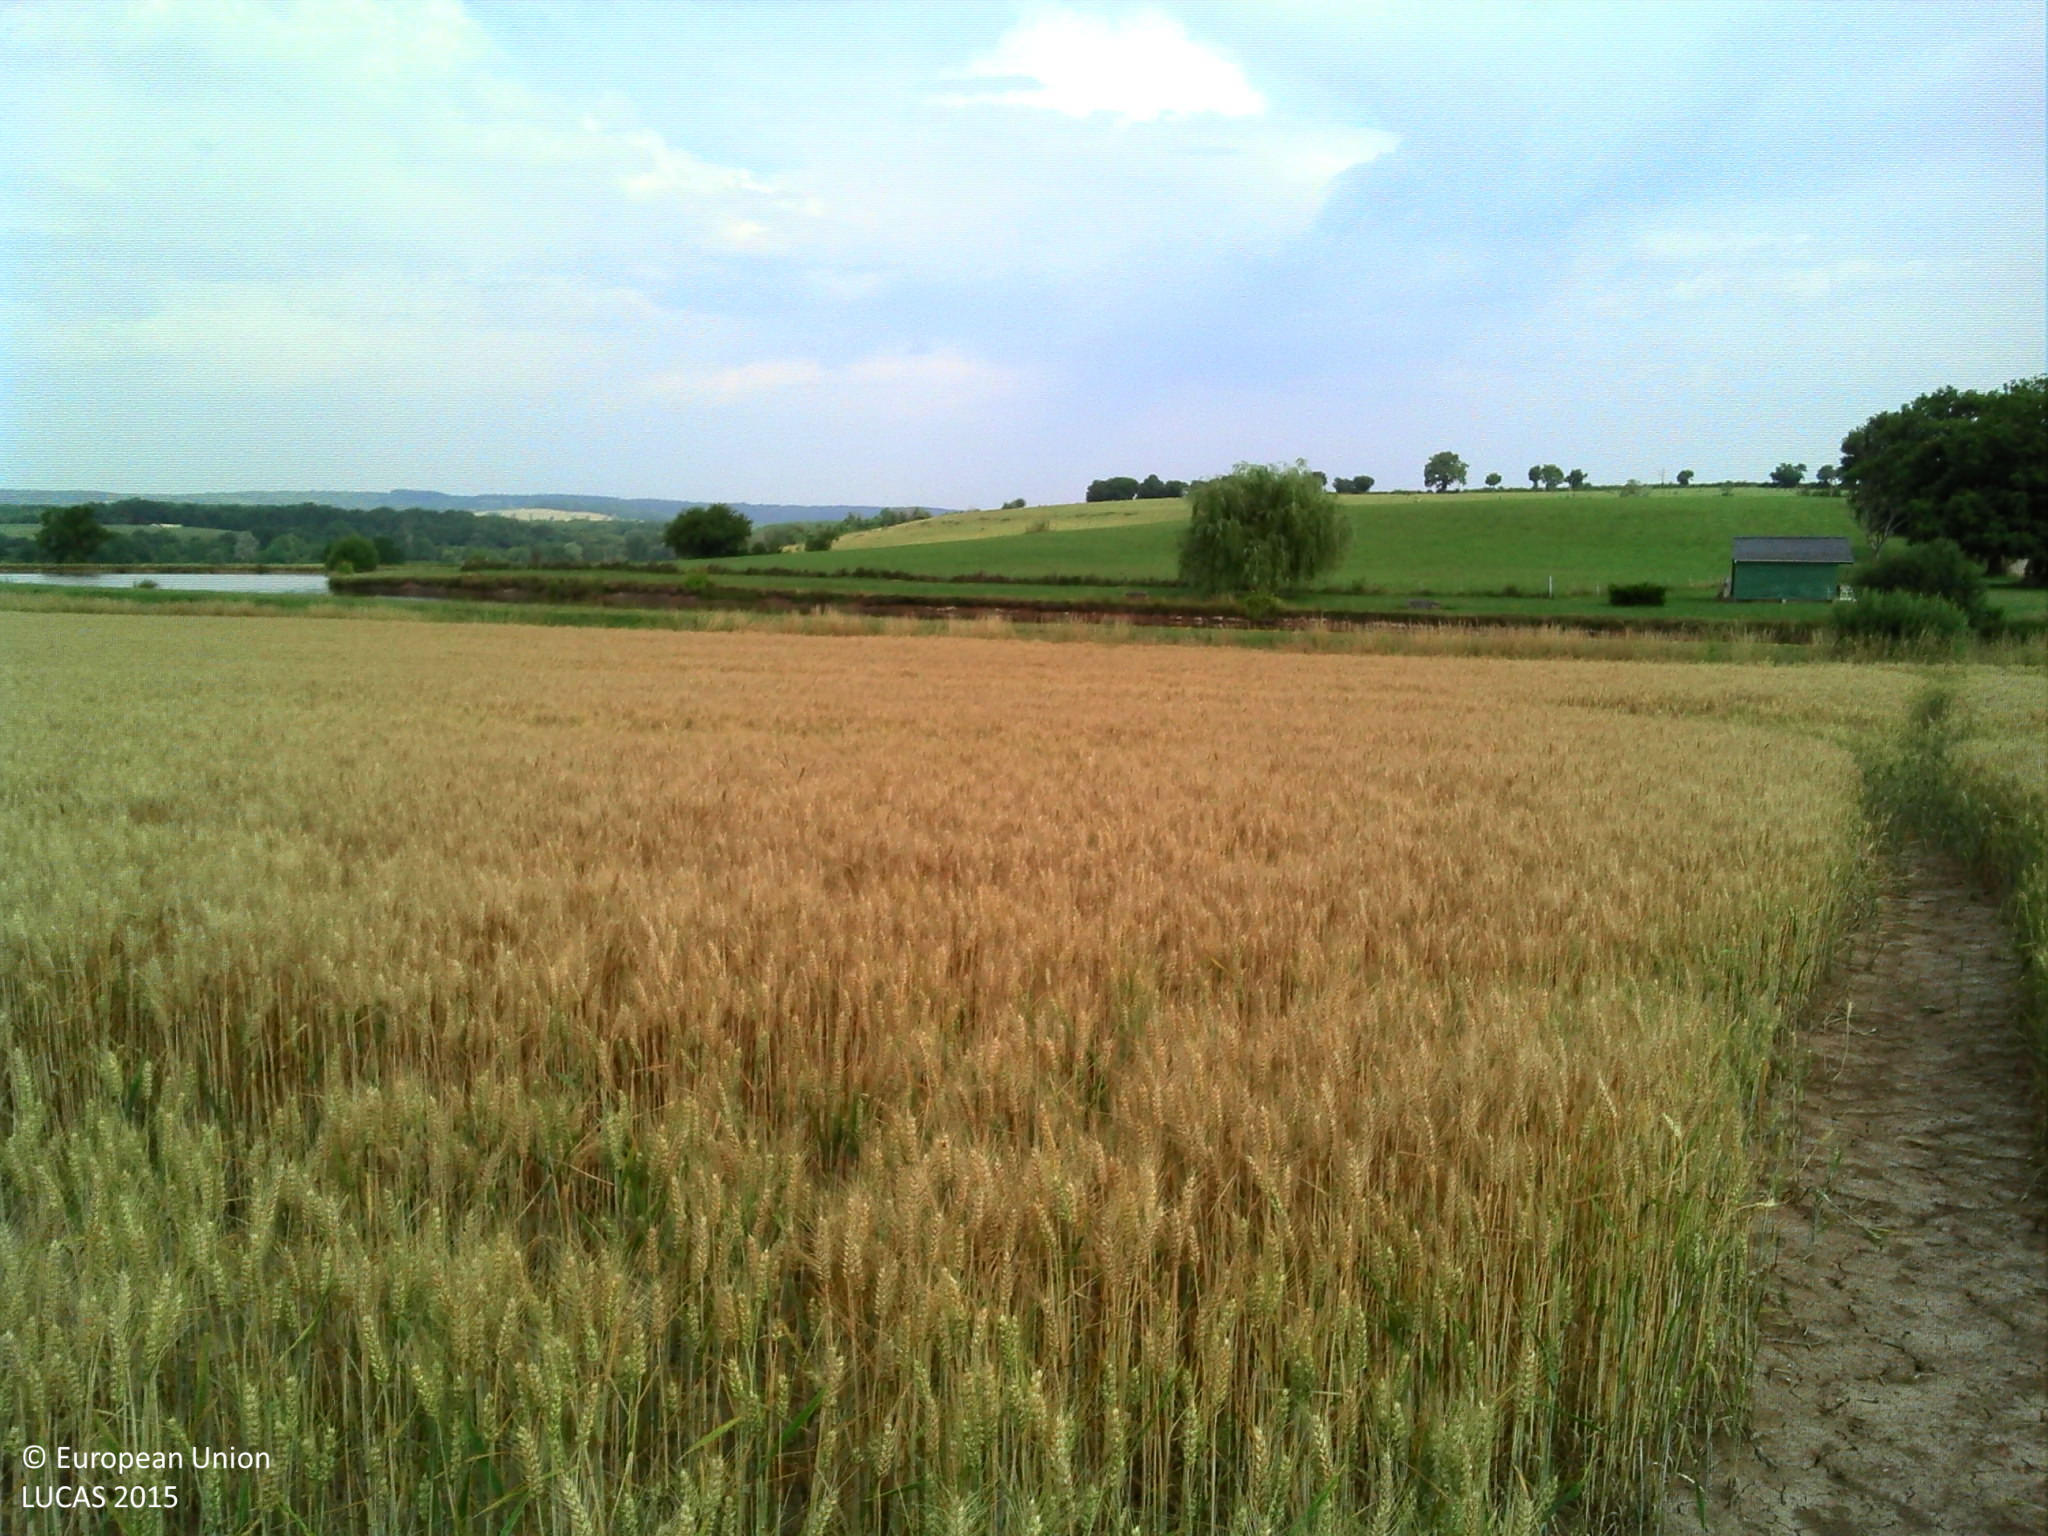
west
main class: Cropland
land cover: Common wheat
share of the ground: > 75 %
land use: Agriculture (excluding fallow land and kitchen gardens)
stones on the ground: < 10 %
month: July
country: FR
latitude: 47.0976
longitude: 3.5812
